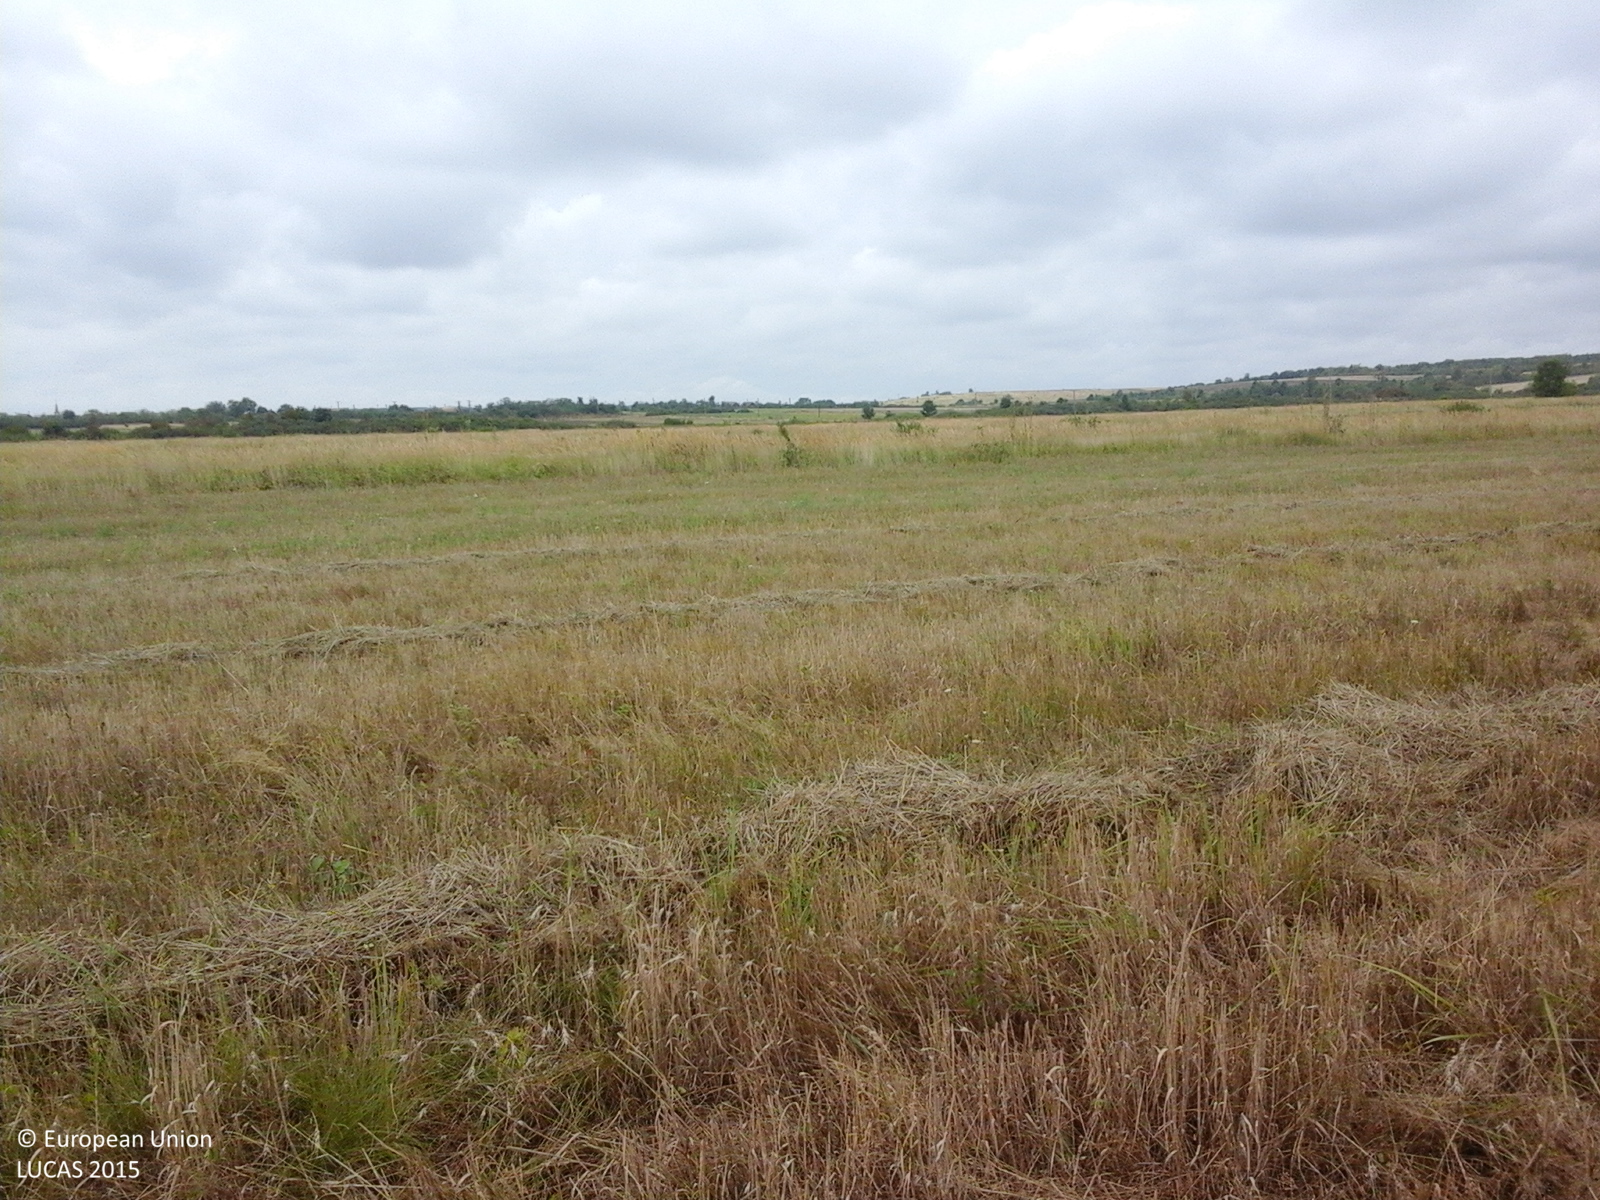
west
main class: Cropland
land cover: Common wheat
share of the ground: > 75 %
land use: Agriculture (excluding fallow land and kitchen gardens)
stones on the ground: < 10 %
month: August
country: RO
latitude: 45.8269
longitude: 21.7641
